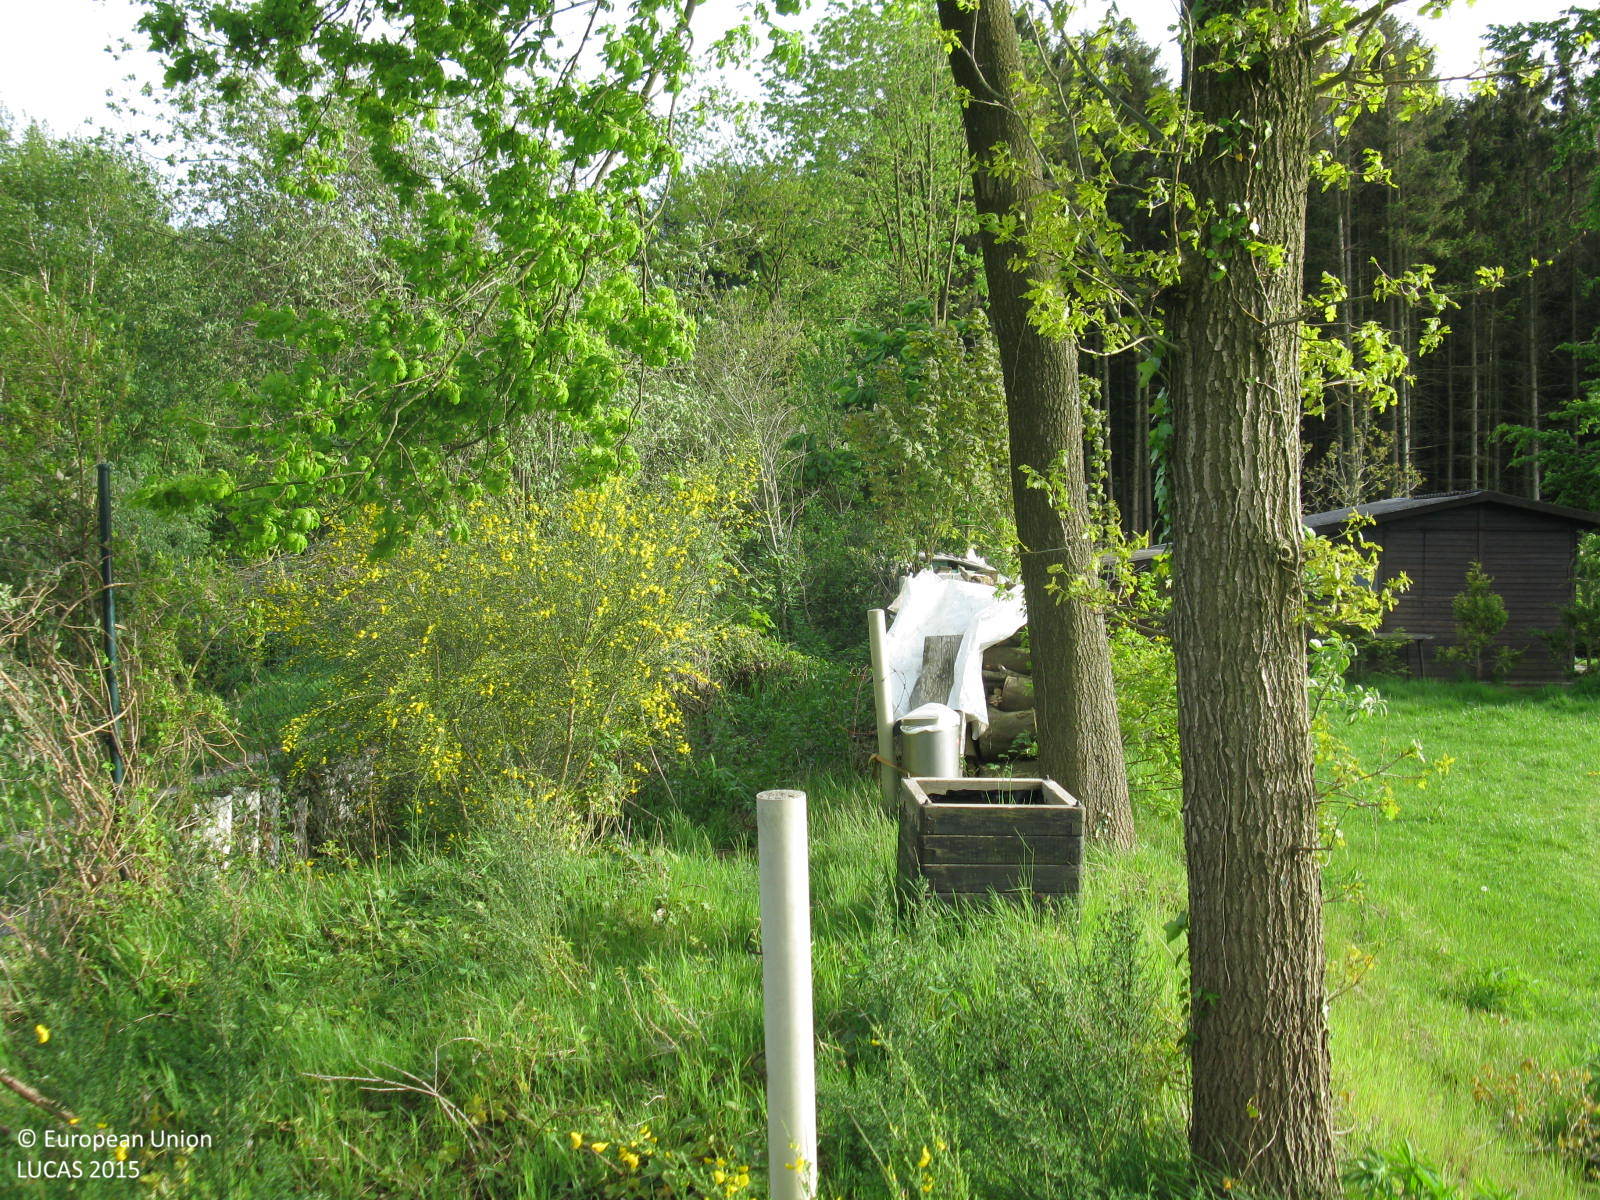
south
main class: Woodland
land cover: Broadleaved woodland
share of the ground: 25 - 50 %
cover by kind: broadleaved forest trees 50 %, herbaceous plants 50 %
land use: Semi-natural and natural areas not in use
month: May
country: DE
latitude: 52.9603
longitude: 7.3953
